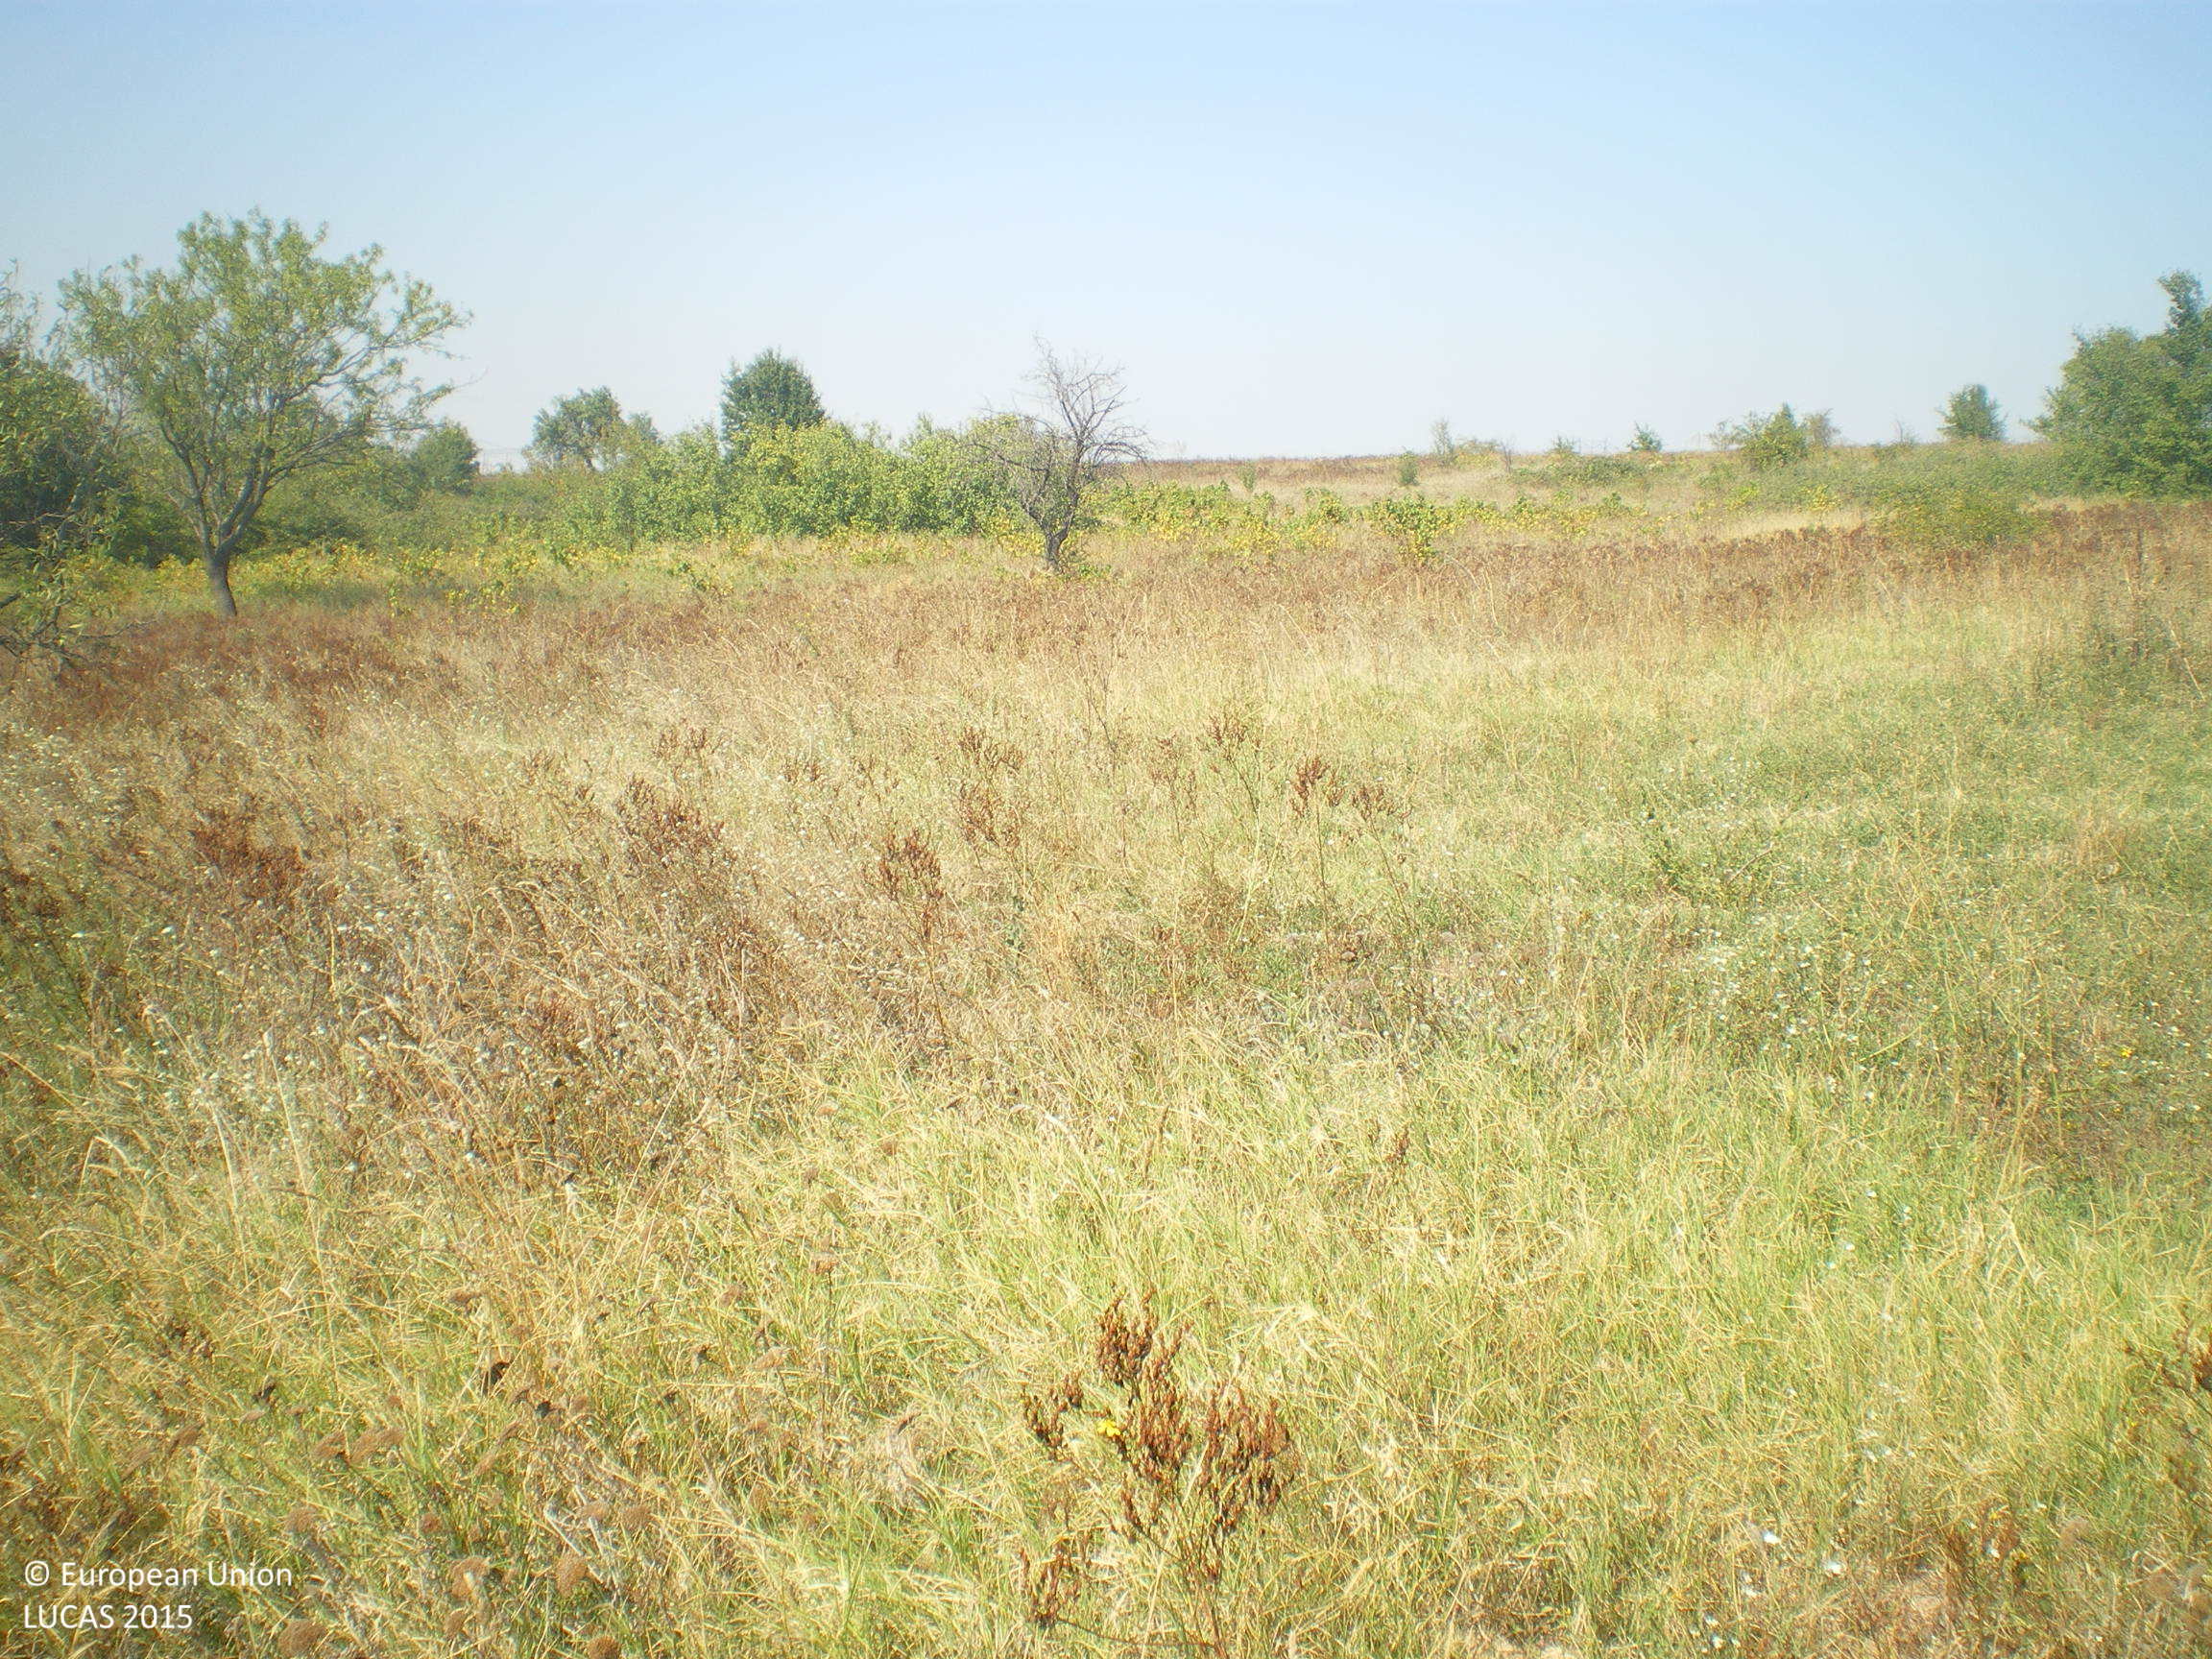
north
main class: Grassland
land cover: Grassland with sparse tree/shrub cover
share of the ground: > 75 %
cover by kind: herbaceous plants 90 %, broadleaved forest trees 5 %, shrubs 5 %
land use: Agriculture (excluding fallow land and kitchen gardens)
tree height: > 5 m
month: August
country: BG
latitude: 42.0428
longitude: 26.0593
